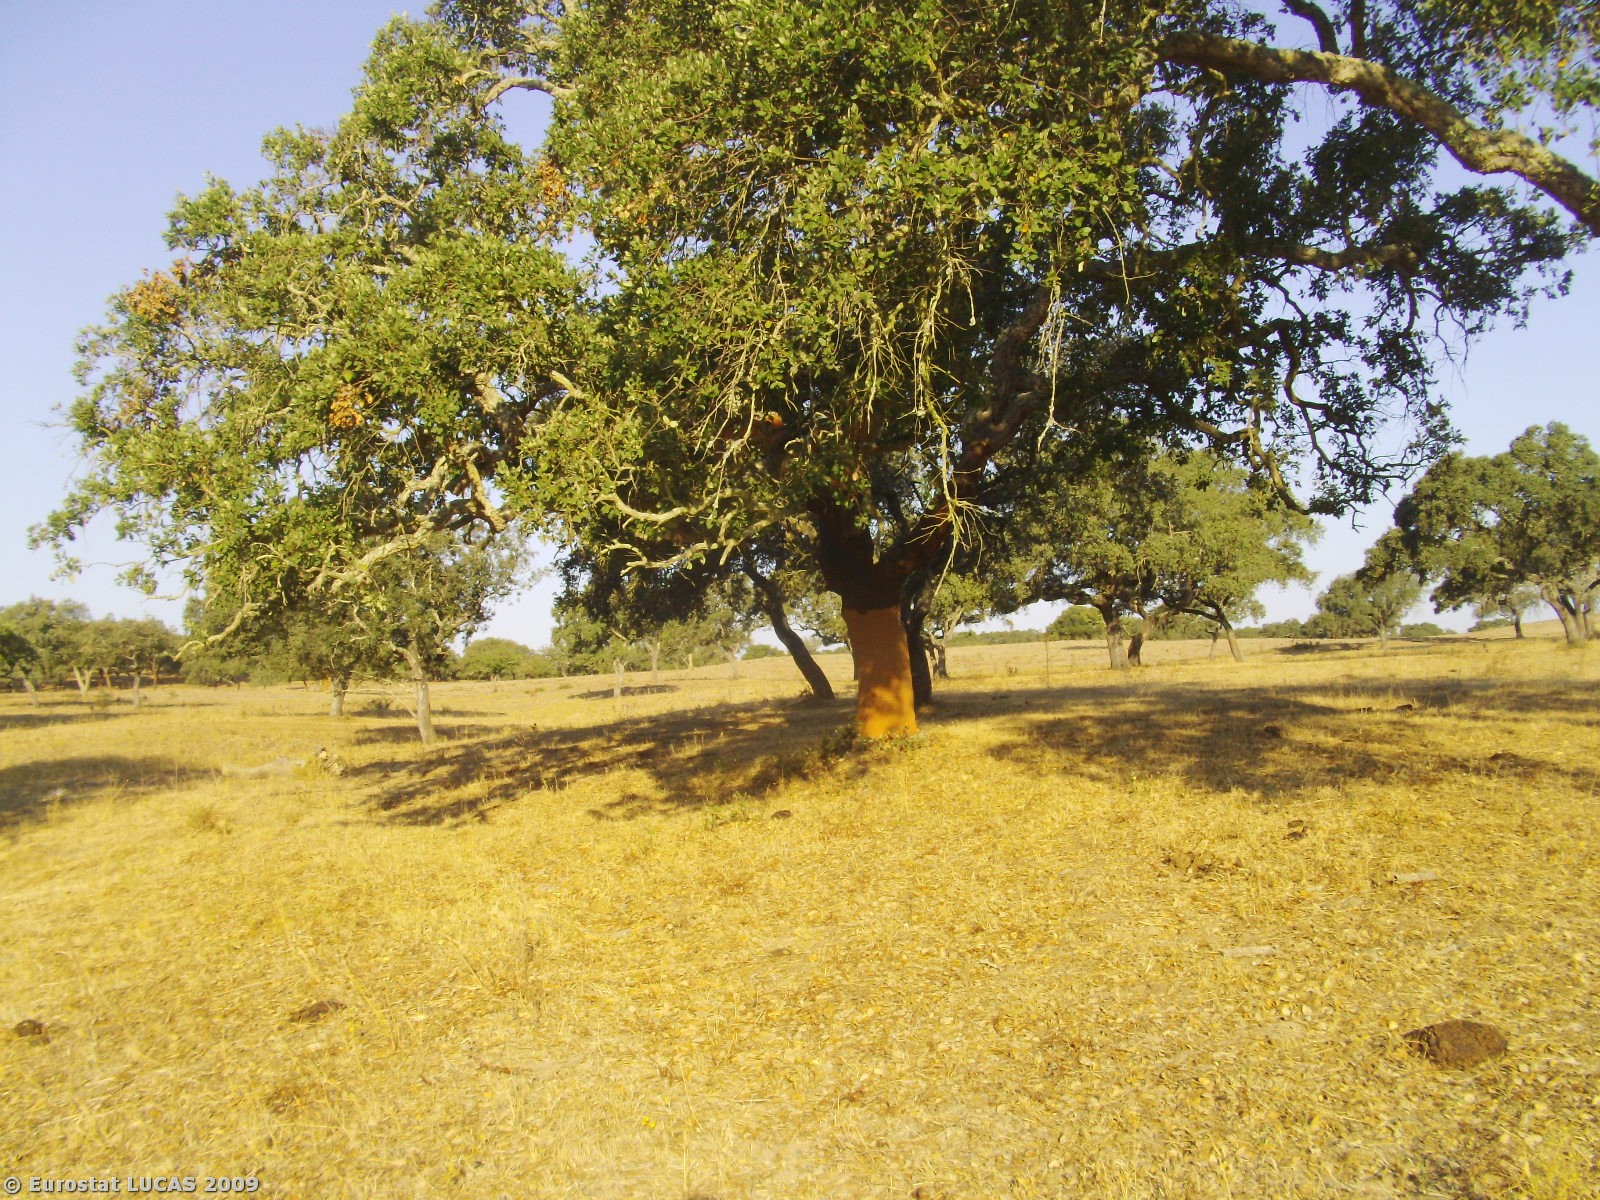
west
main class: Woodland
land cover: Broadleaved woodland
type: broadleaved evergreen forest
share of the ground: 25 - 50 %
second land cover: Spontaneously vegetated surfaces
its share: 25 - 50 %
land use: Forestry
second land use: Fallow land
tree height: > 5 m
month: August
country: PT
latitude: 38.0301
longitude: -8.4879
